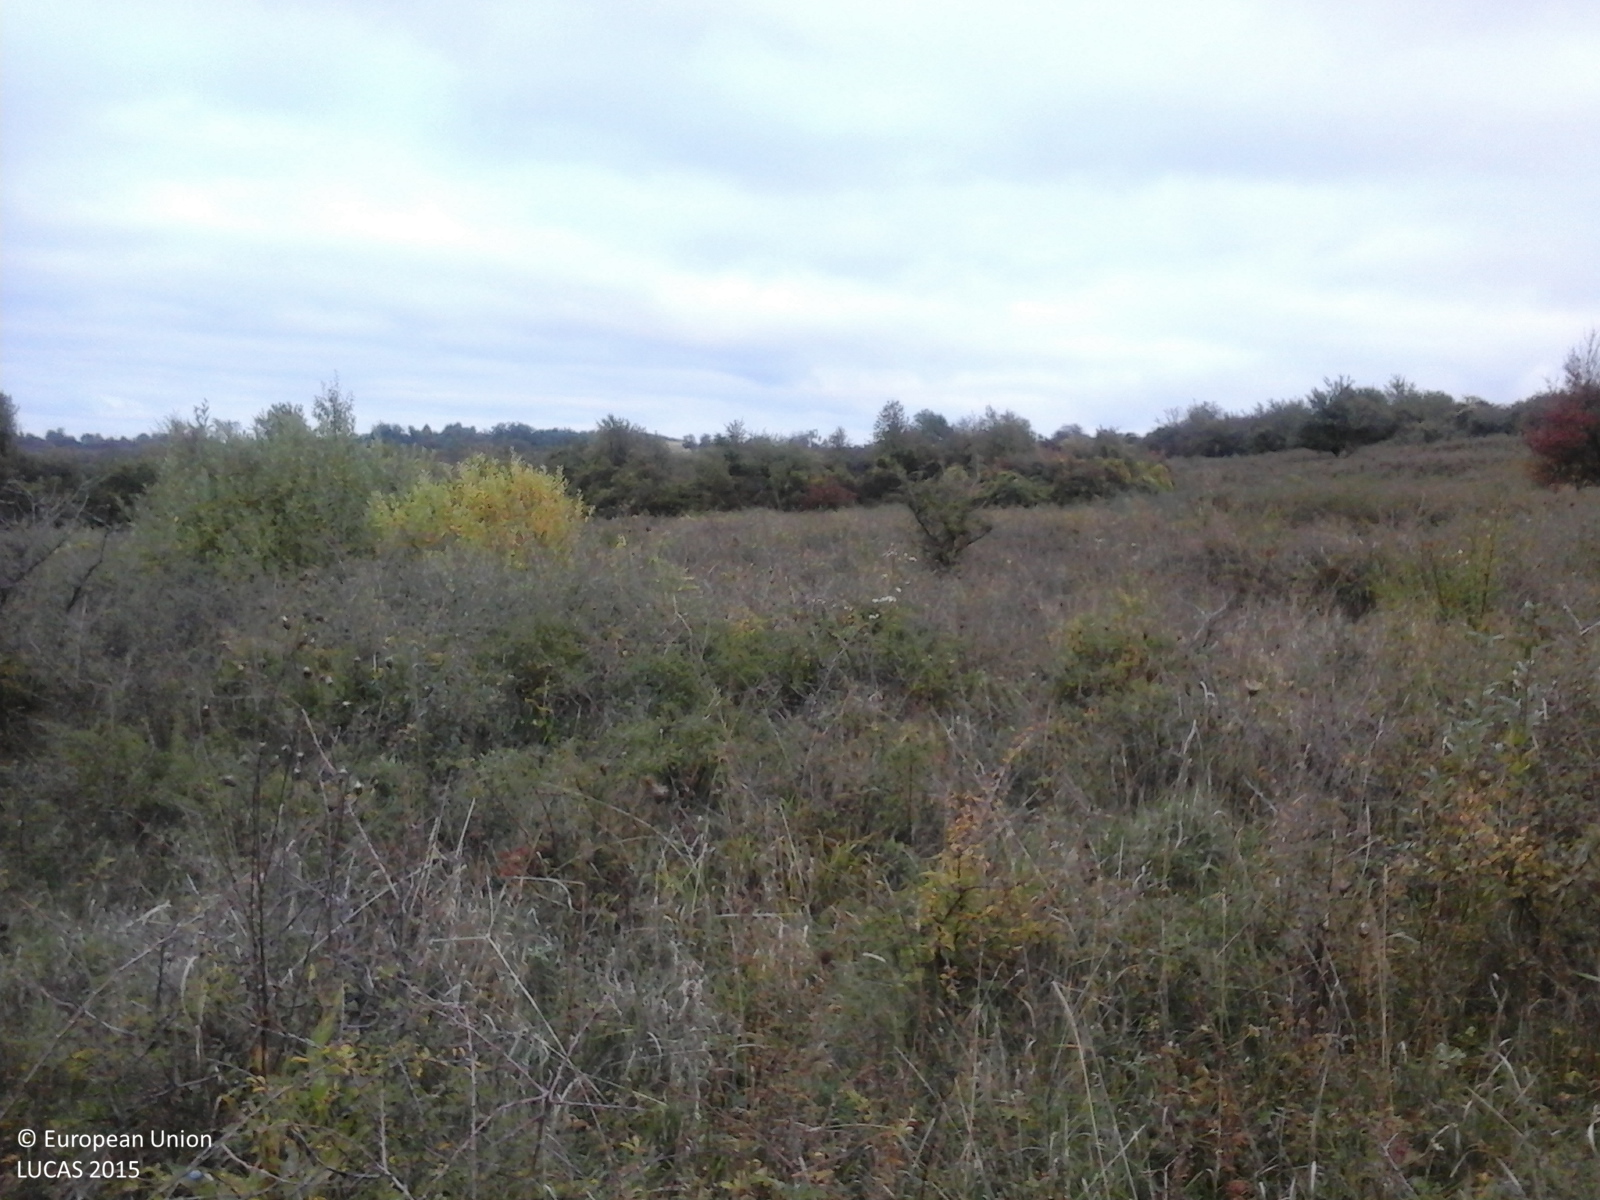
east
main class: Shrubland
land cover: Shrubland without tree cover
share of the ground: > 75 %
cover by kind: shrubs 100 %
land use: Semi-natural and natural areas not in use
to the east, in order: Shrubland without tree cover; Broadleaved woodland
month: October
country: RO
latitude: 45.9748
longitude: 24.7896
